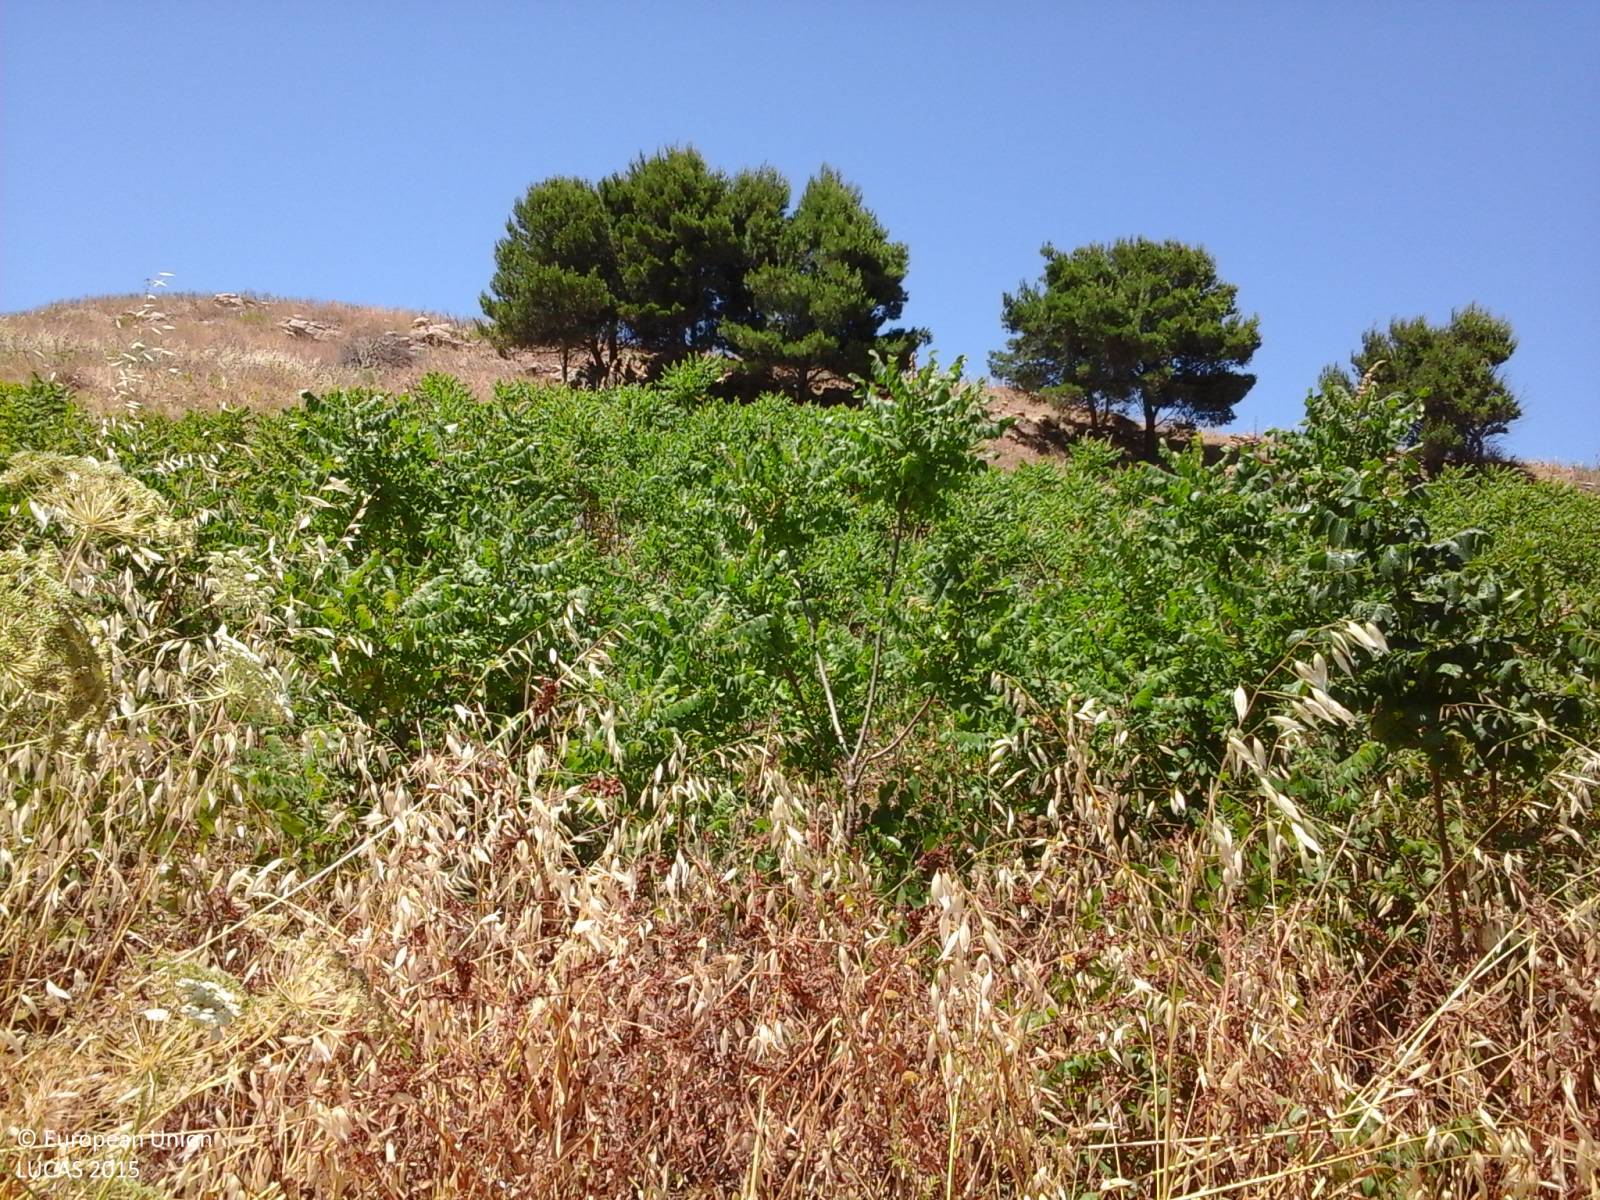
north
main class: Cropland
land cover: Olive groves
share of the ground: 50 - 75 %
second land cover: Other bare soil
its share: > 75 %
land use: Agriculture (excluding fallow land and kitchen gardens)
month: June
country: IT
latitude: 37.9822
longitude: 12.6789
